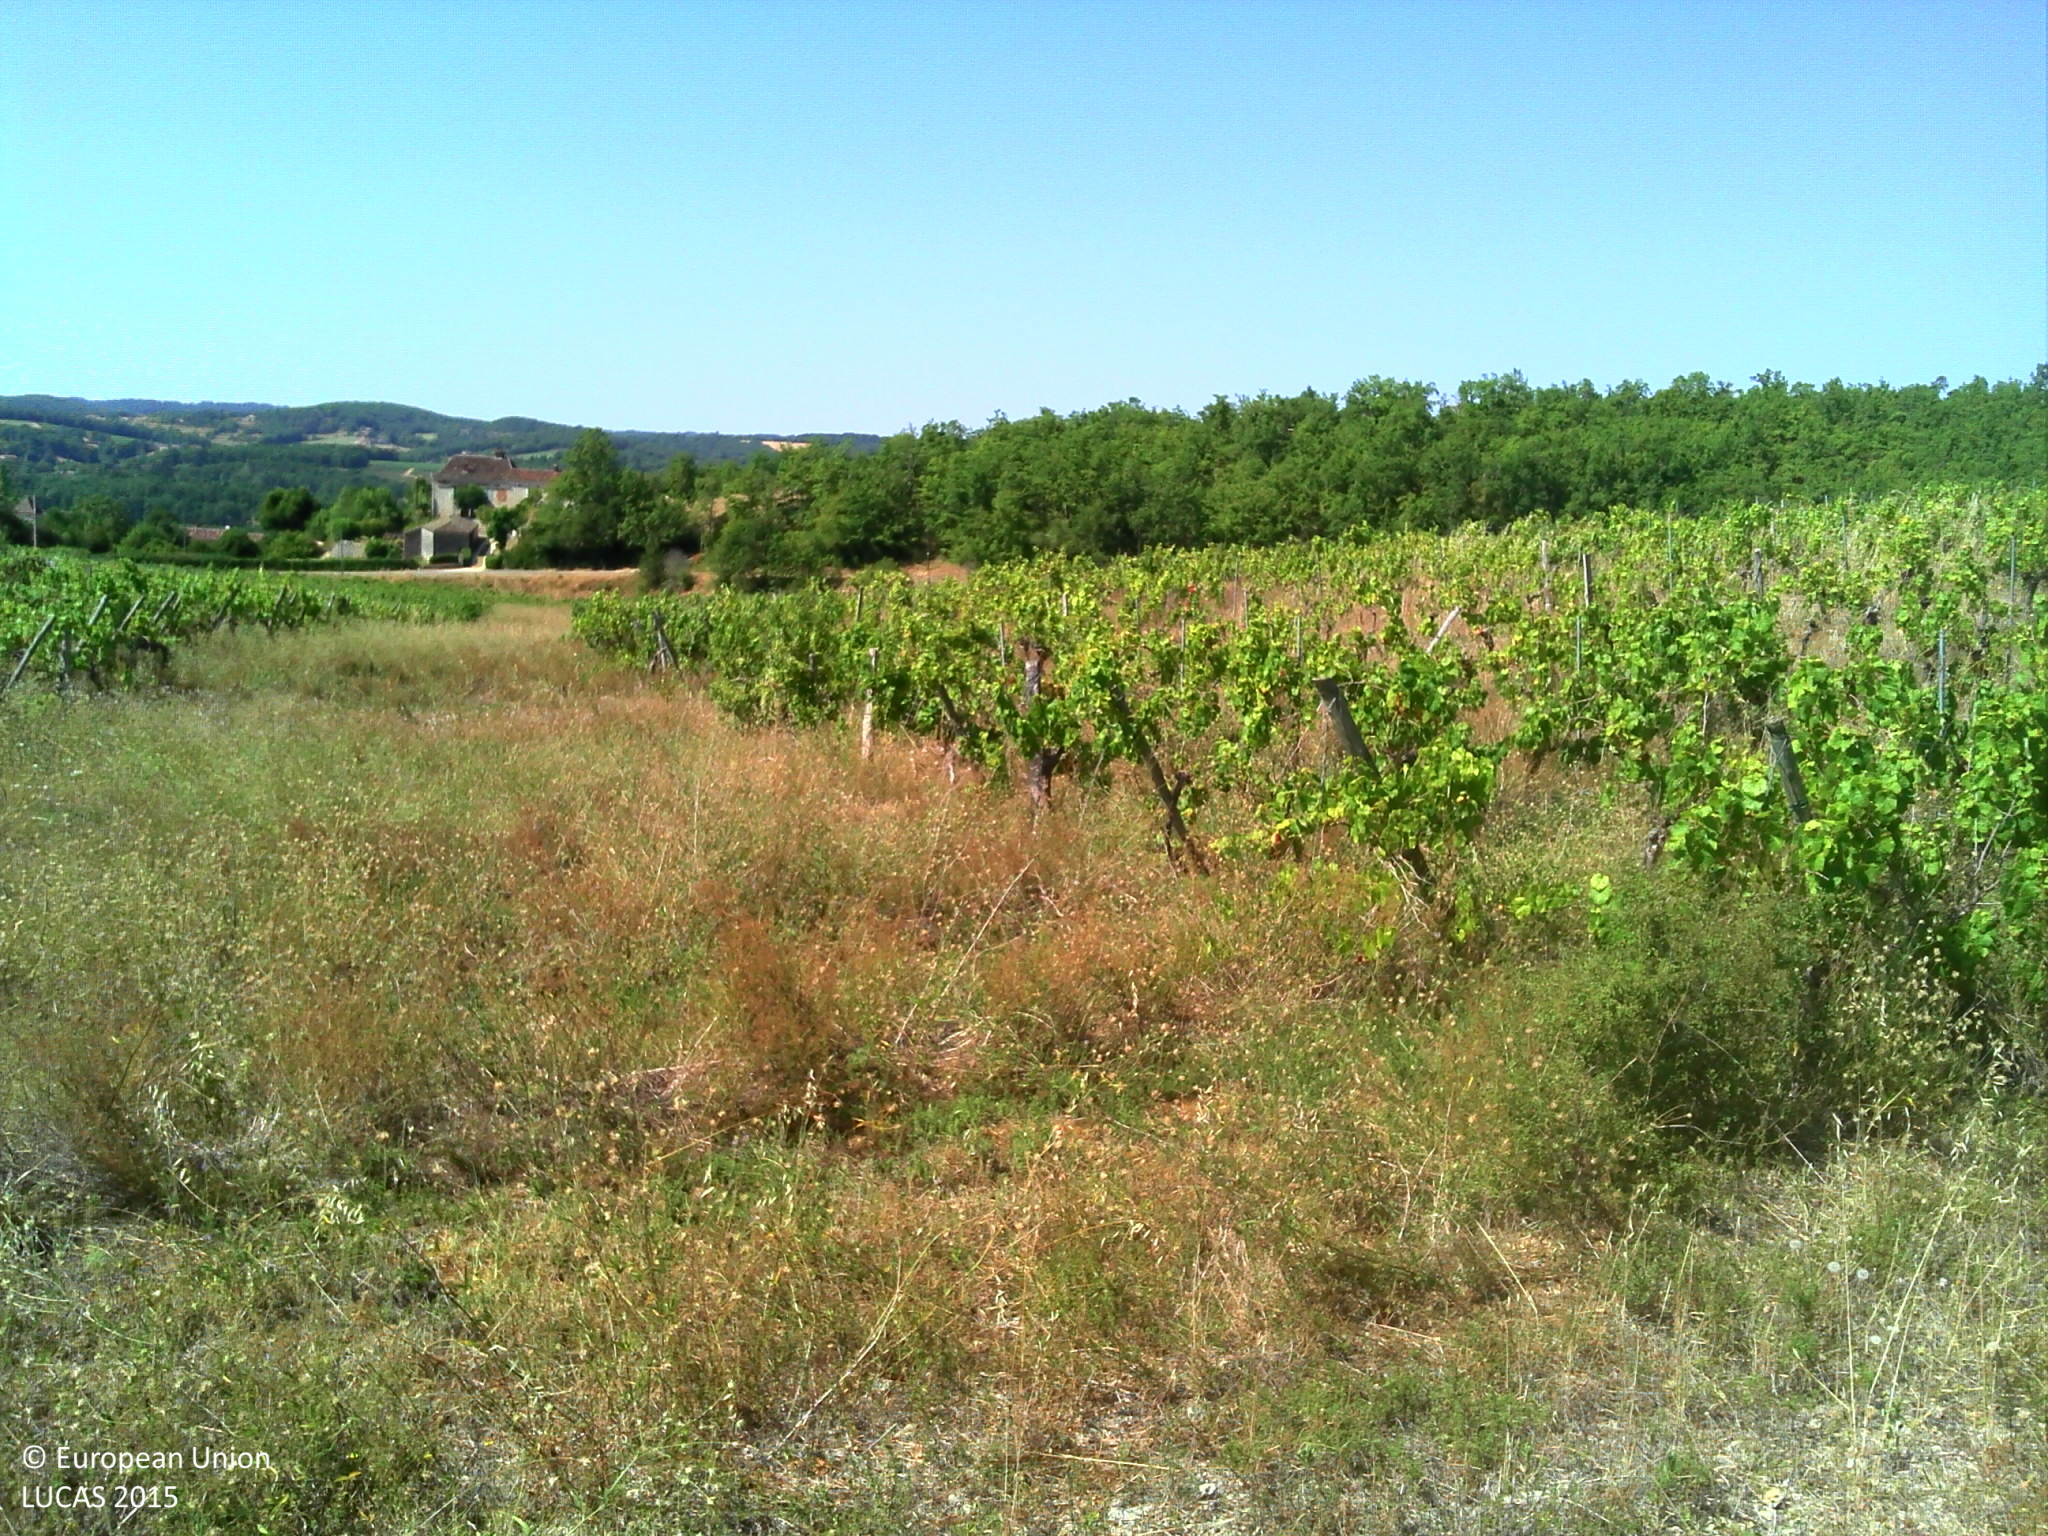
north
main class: Grassland
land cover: Grassland without tree/shrub cover
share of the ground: > 75 %
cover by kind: herbaceous plants 100 %
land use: Agriculture (excluding fallow land and kitchen gardens)
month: July
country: FR
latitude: 44.4695
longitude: 1.0331
